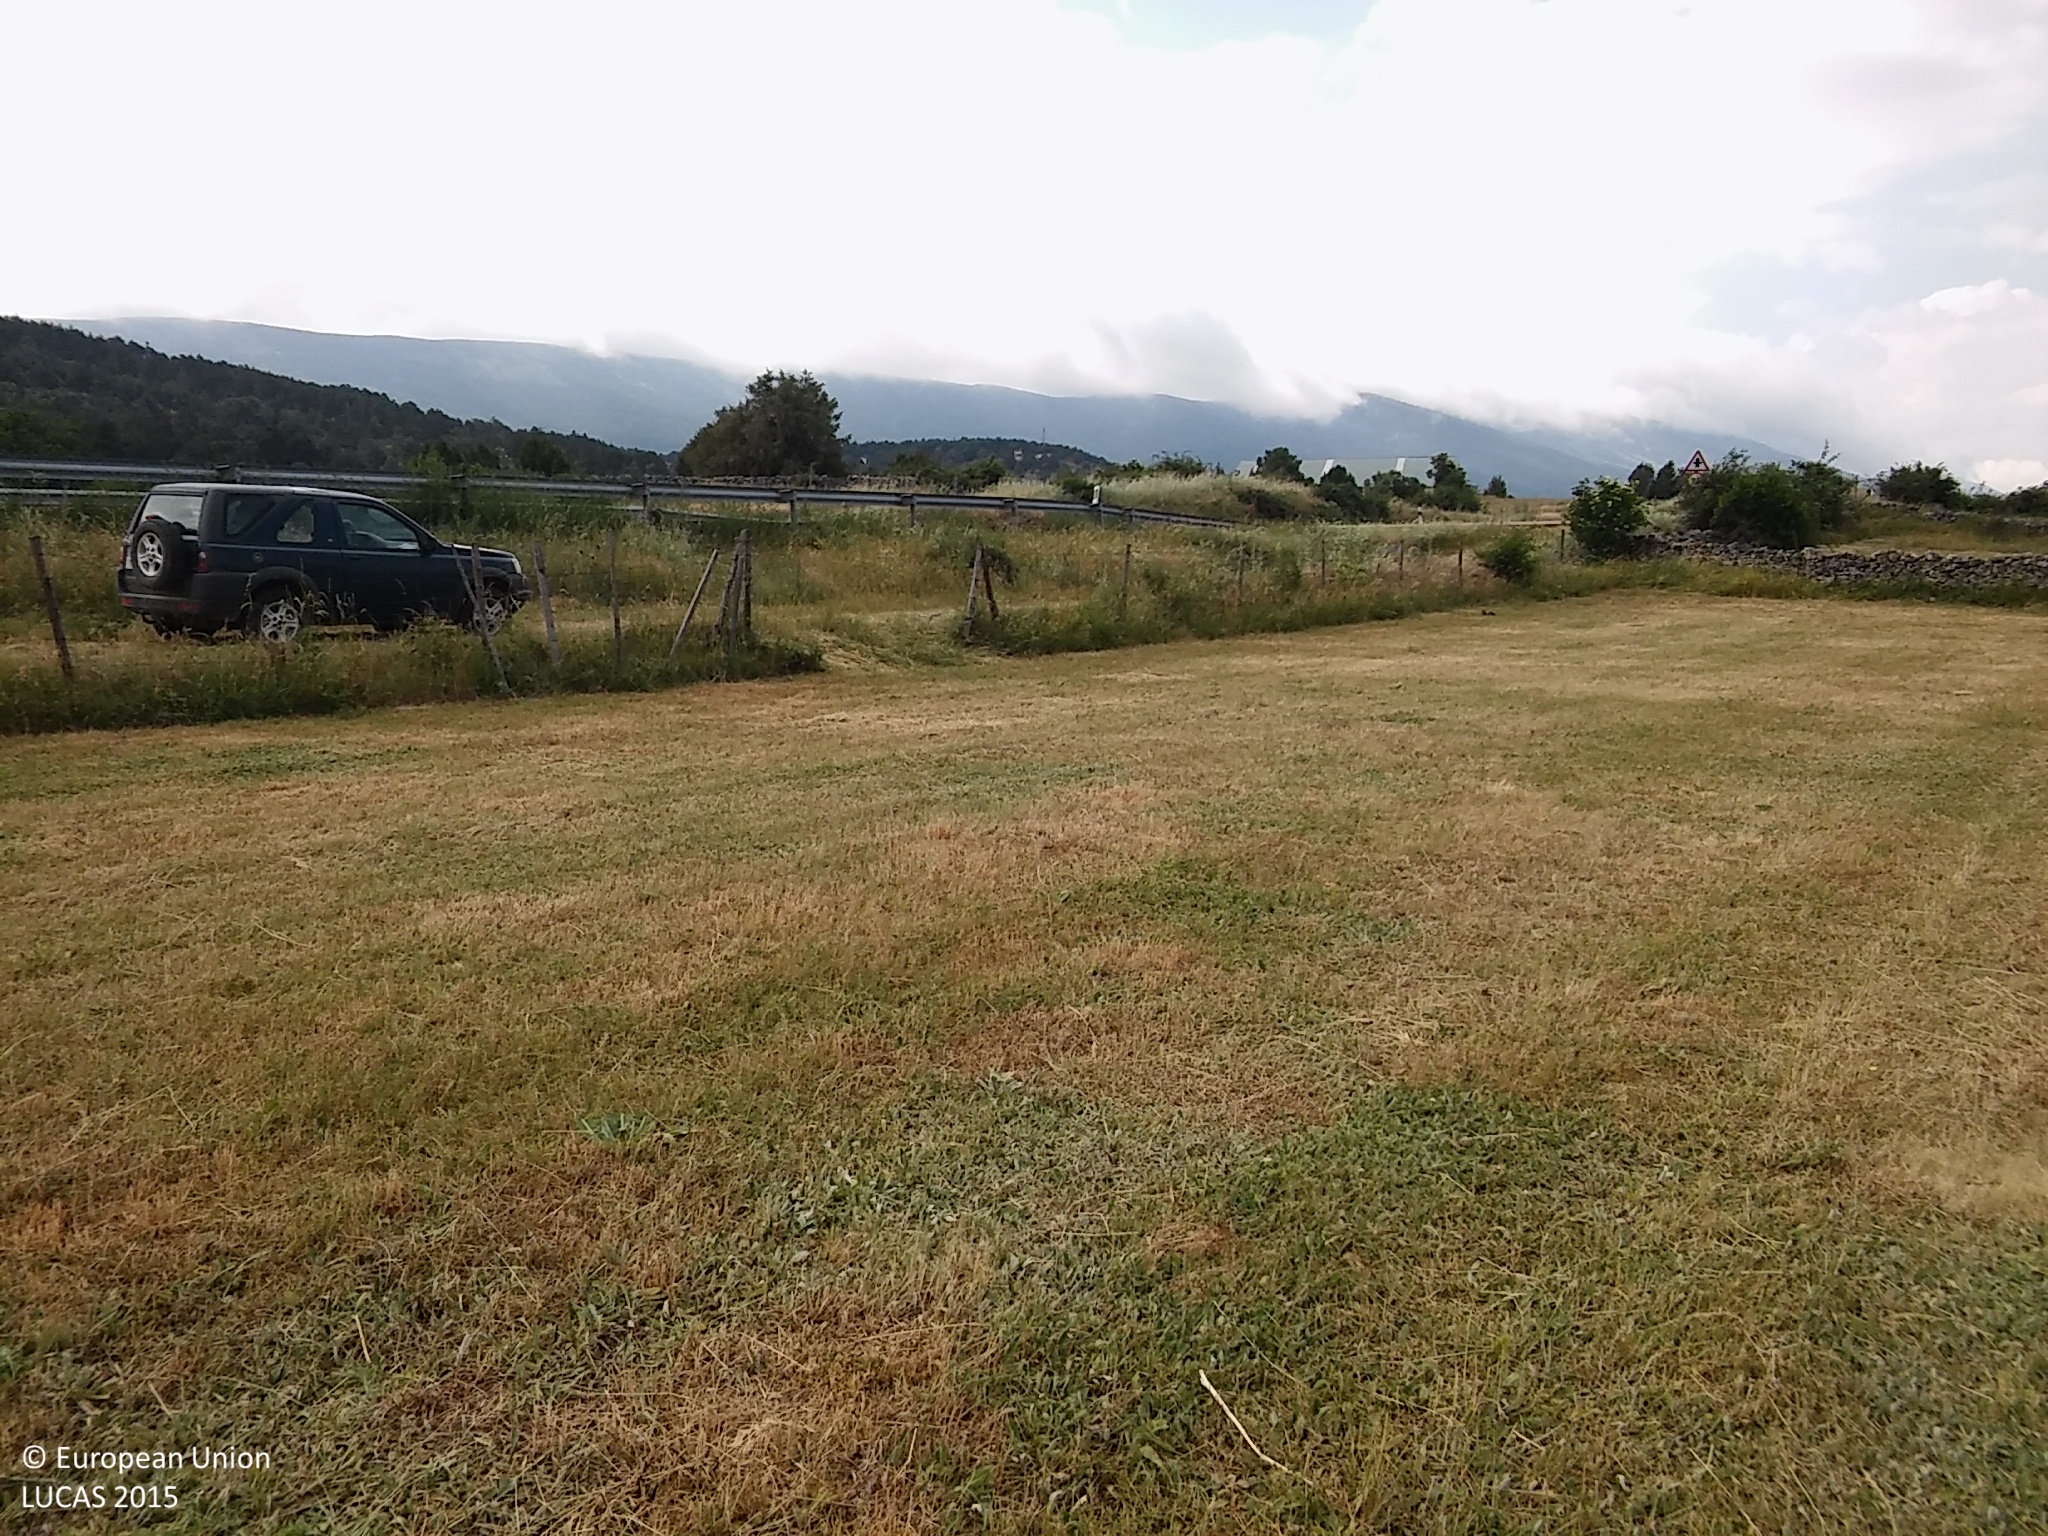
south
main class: Grassland
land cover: Grassland without tree/shrub cover
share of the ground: > 75 %
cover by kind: herbaceous plants 100 %
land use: Agriculture (excluding fallow land and kitchen gardens)
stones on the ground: 10 - 25 %
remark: Harvested field
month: June
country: ES
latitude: 41.1345
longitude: -3.6864
